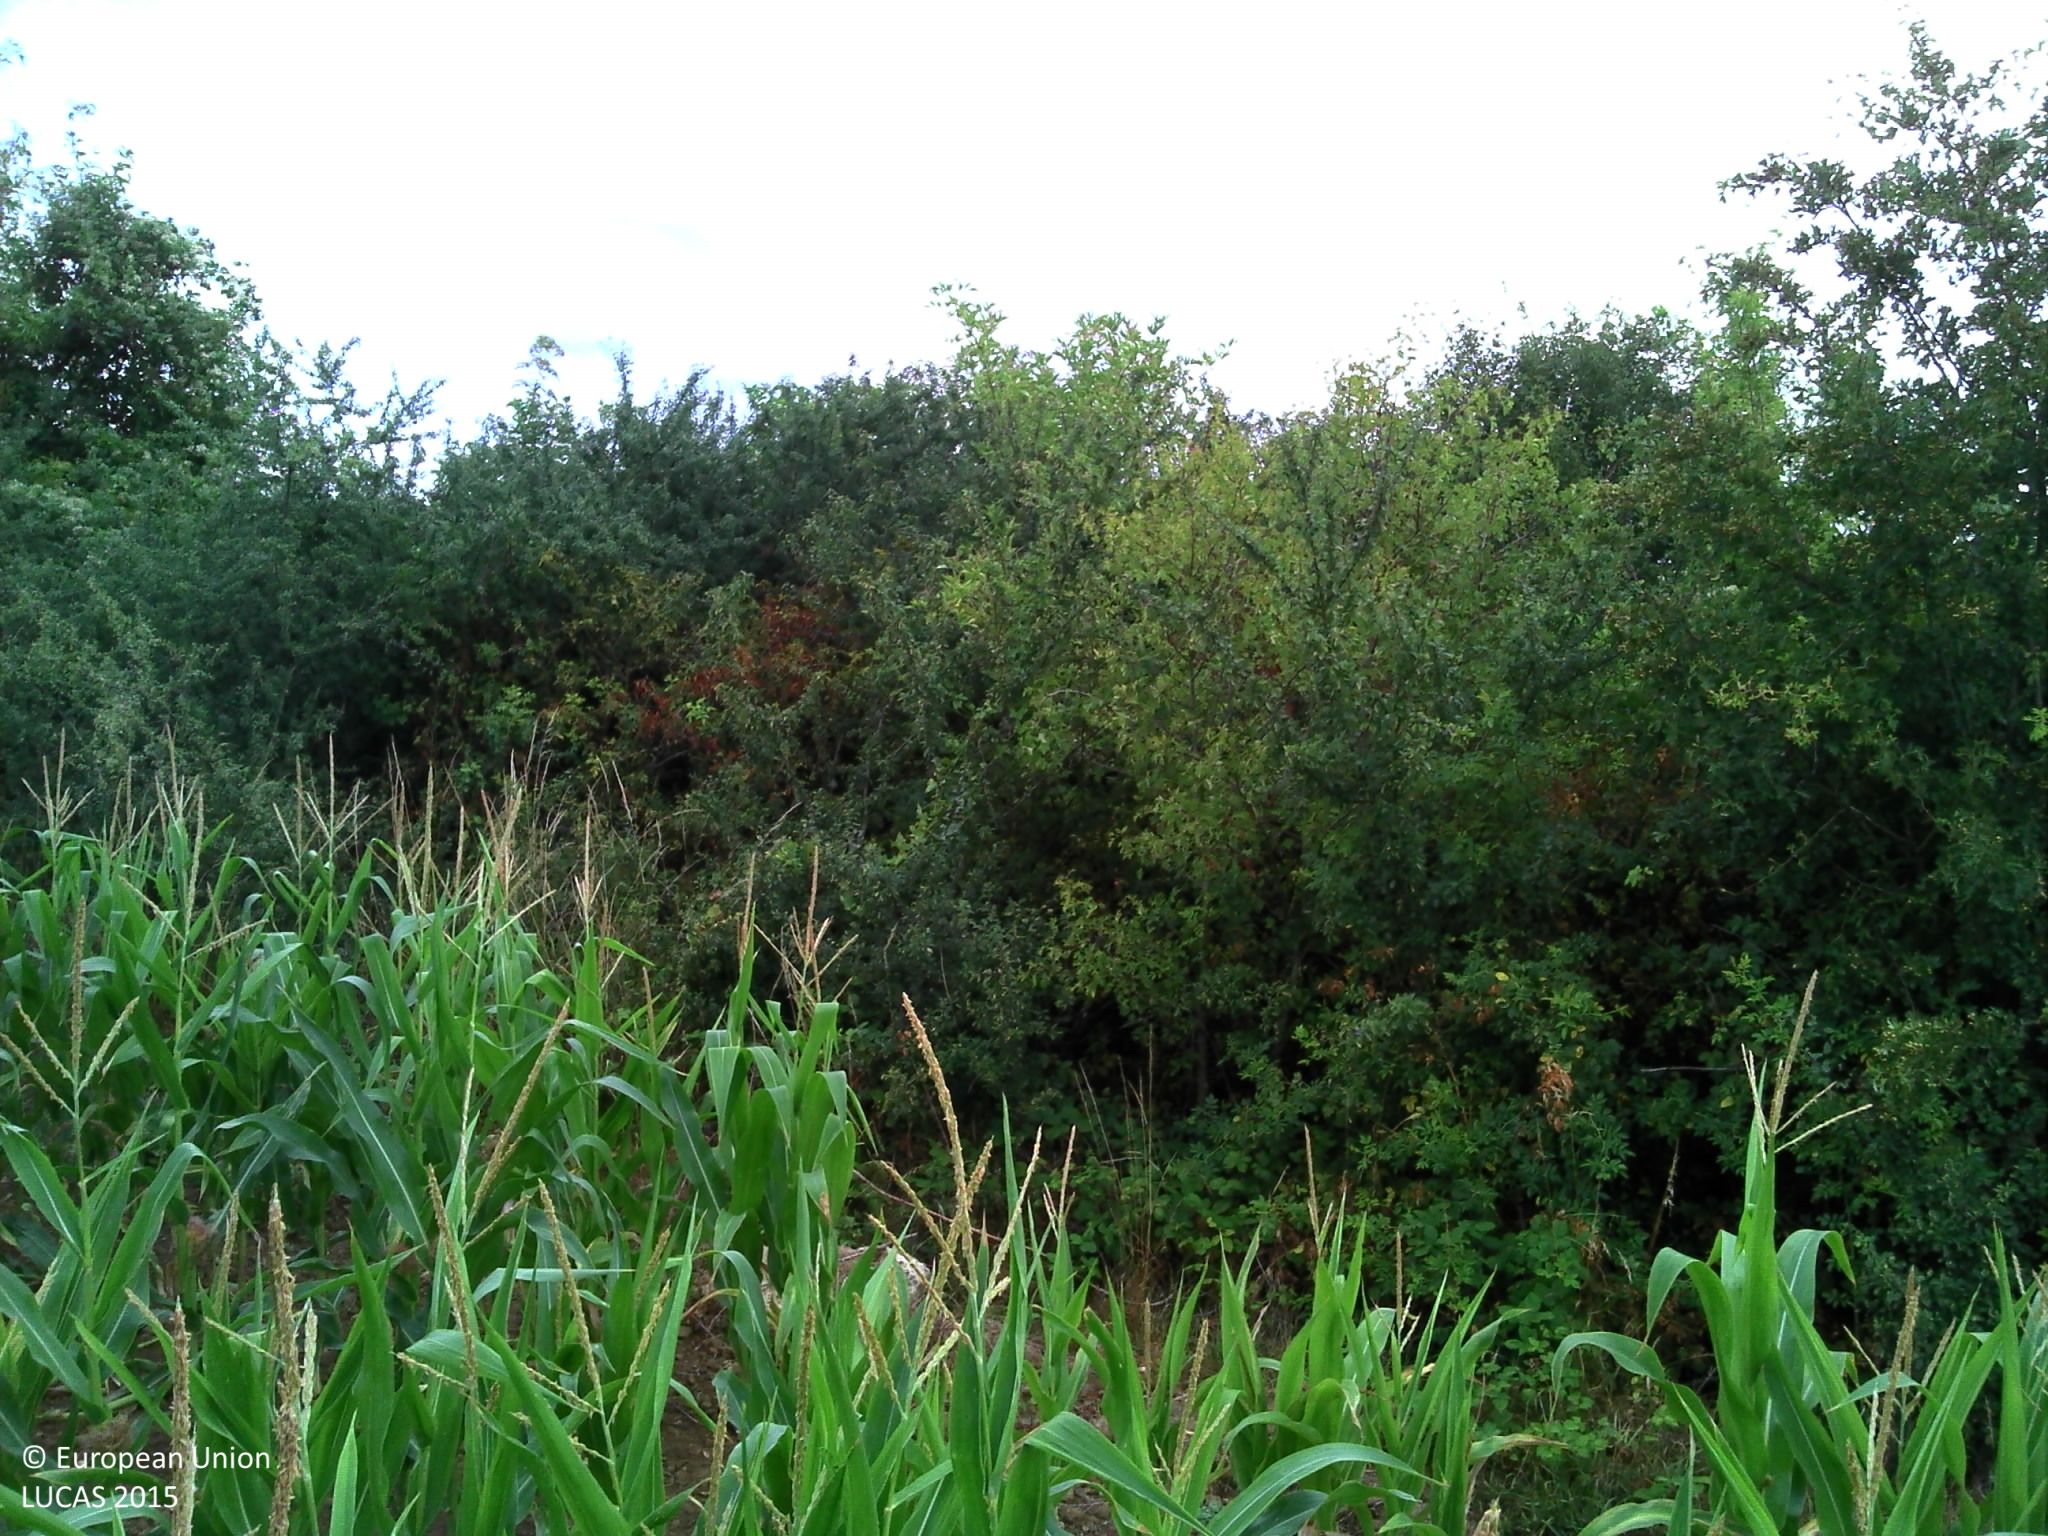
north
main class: Cropland
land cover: Maize
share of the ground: > 75 %
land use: Agriculture (excluding fallow land and kitchen gardens)
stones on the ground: < 10 %
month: July
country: FR
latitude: 49.2204
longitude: 2.5885
